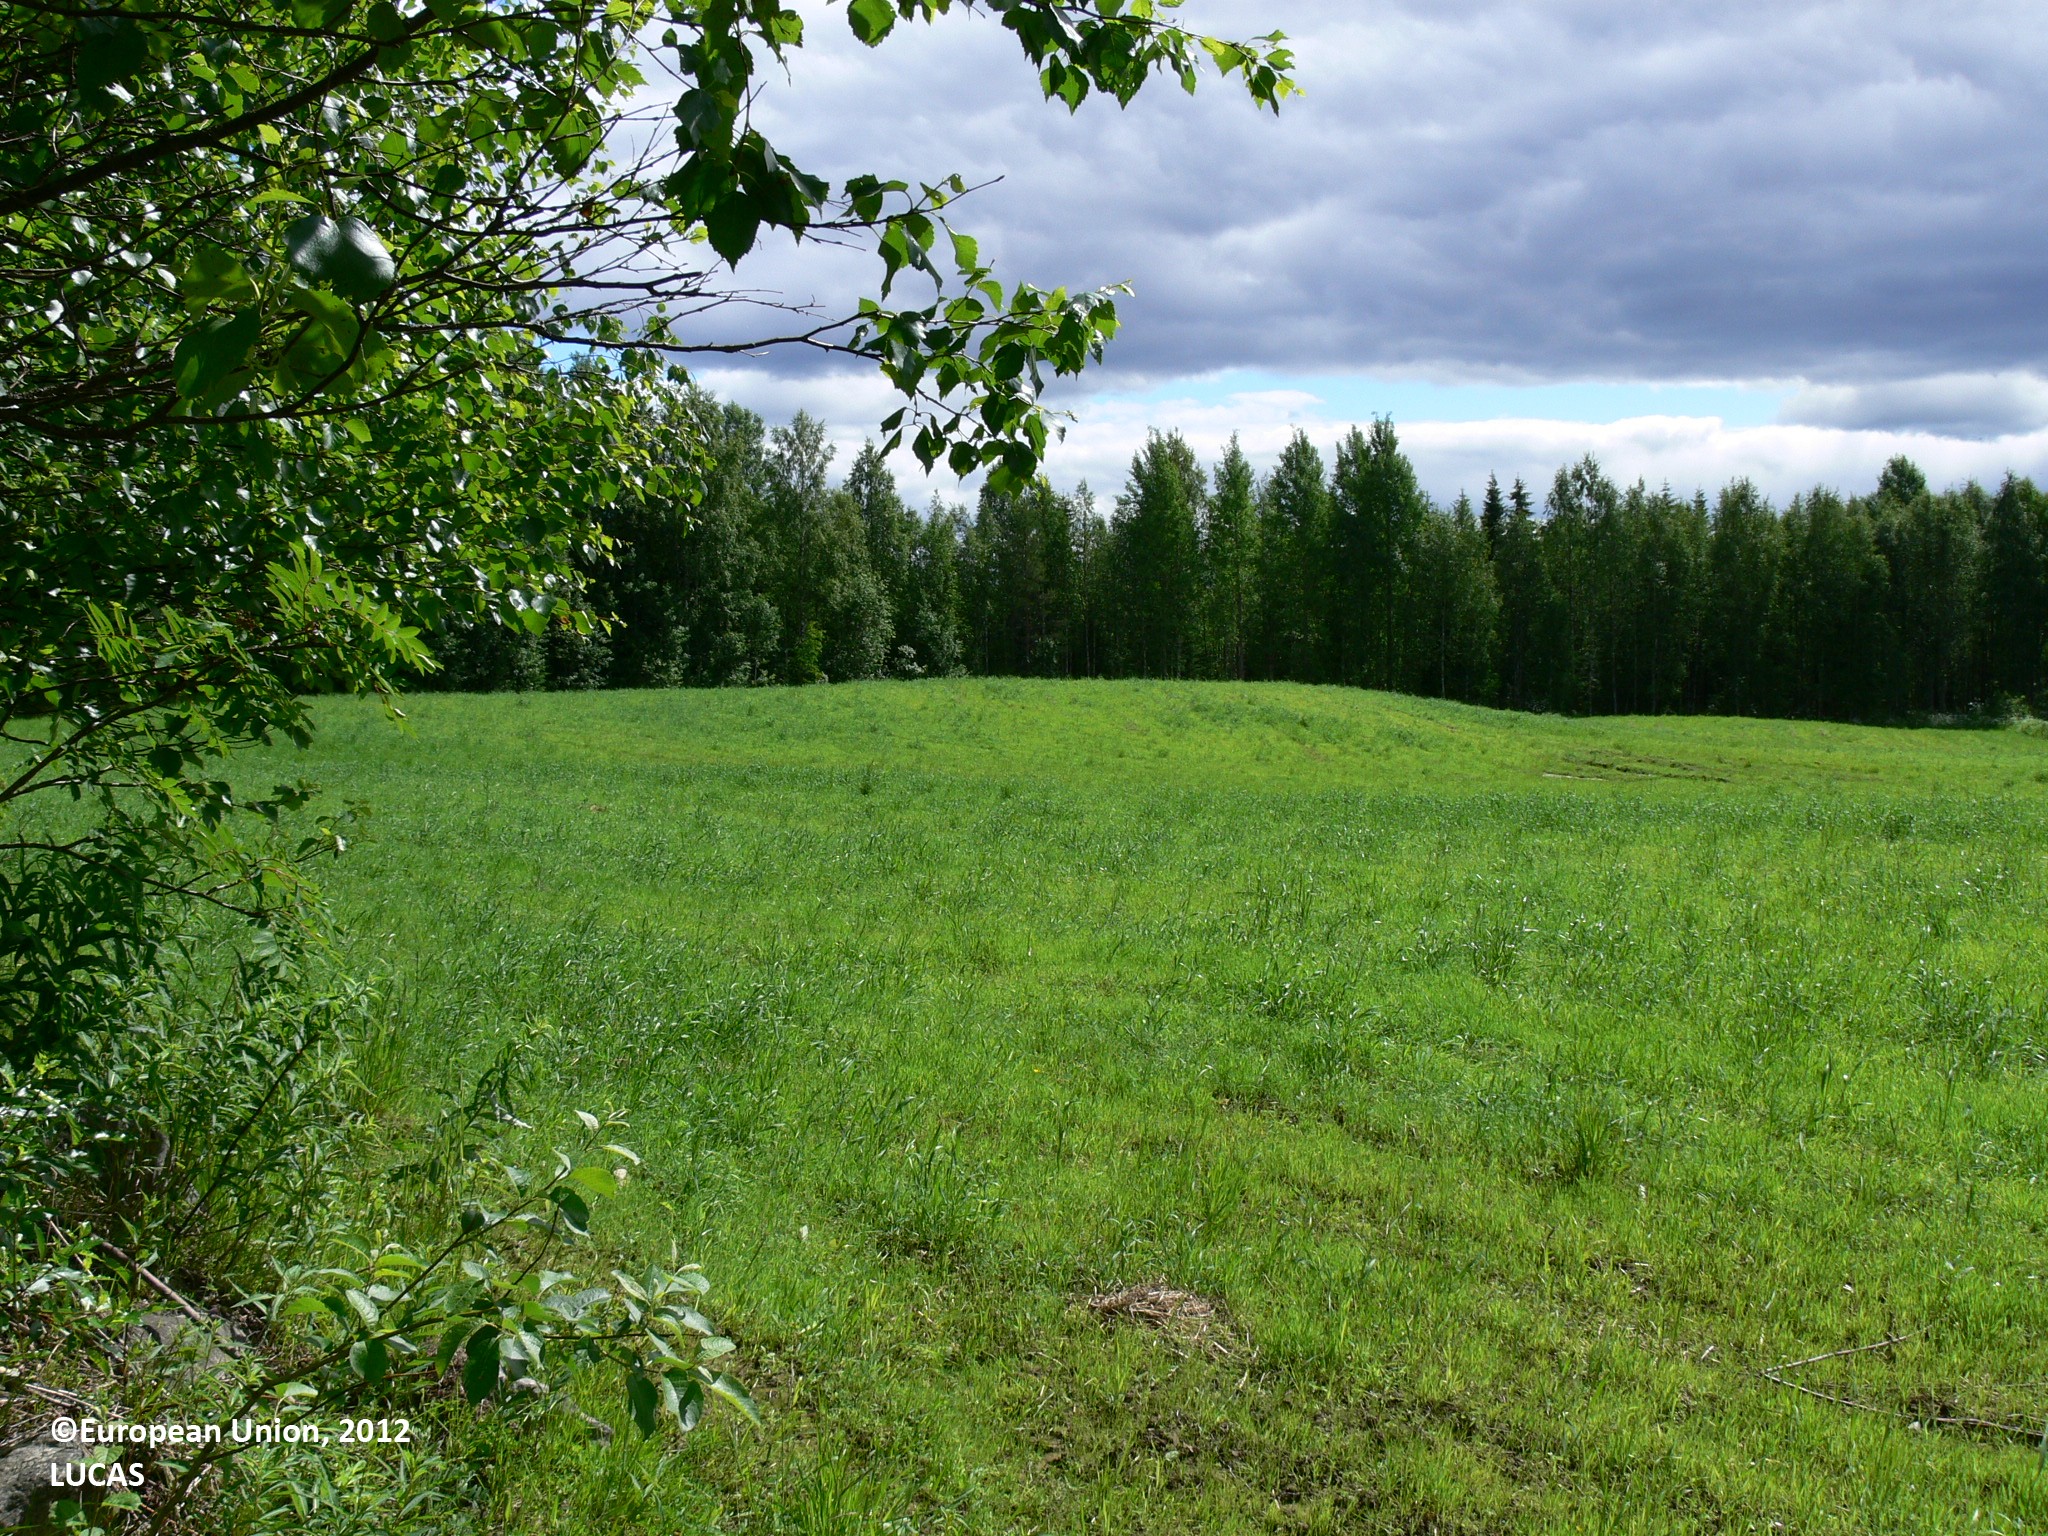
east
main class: Cropland
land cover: Temporary grasslands
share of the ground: 25 - 50 %
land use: Agriculture (excluding fallow land and kitchen gardens)
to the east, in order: Temporary grasslands; Fences; Other mixed woodland; Ditches and canals; Other mixed woodland; Shrubland without tree cover; Electric lines; Shrubland without tree cover; Spruce dominated mixed woodland
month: June
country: FI
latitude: 62.7197
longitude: 30.7268
